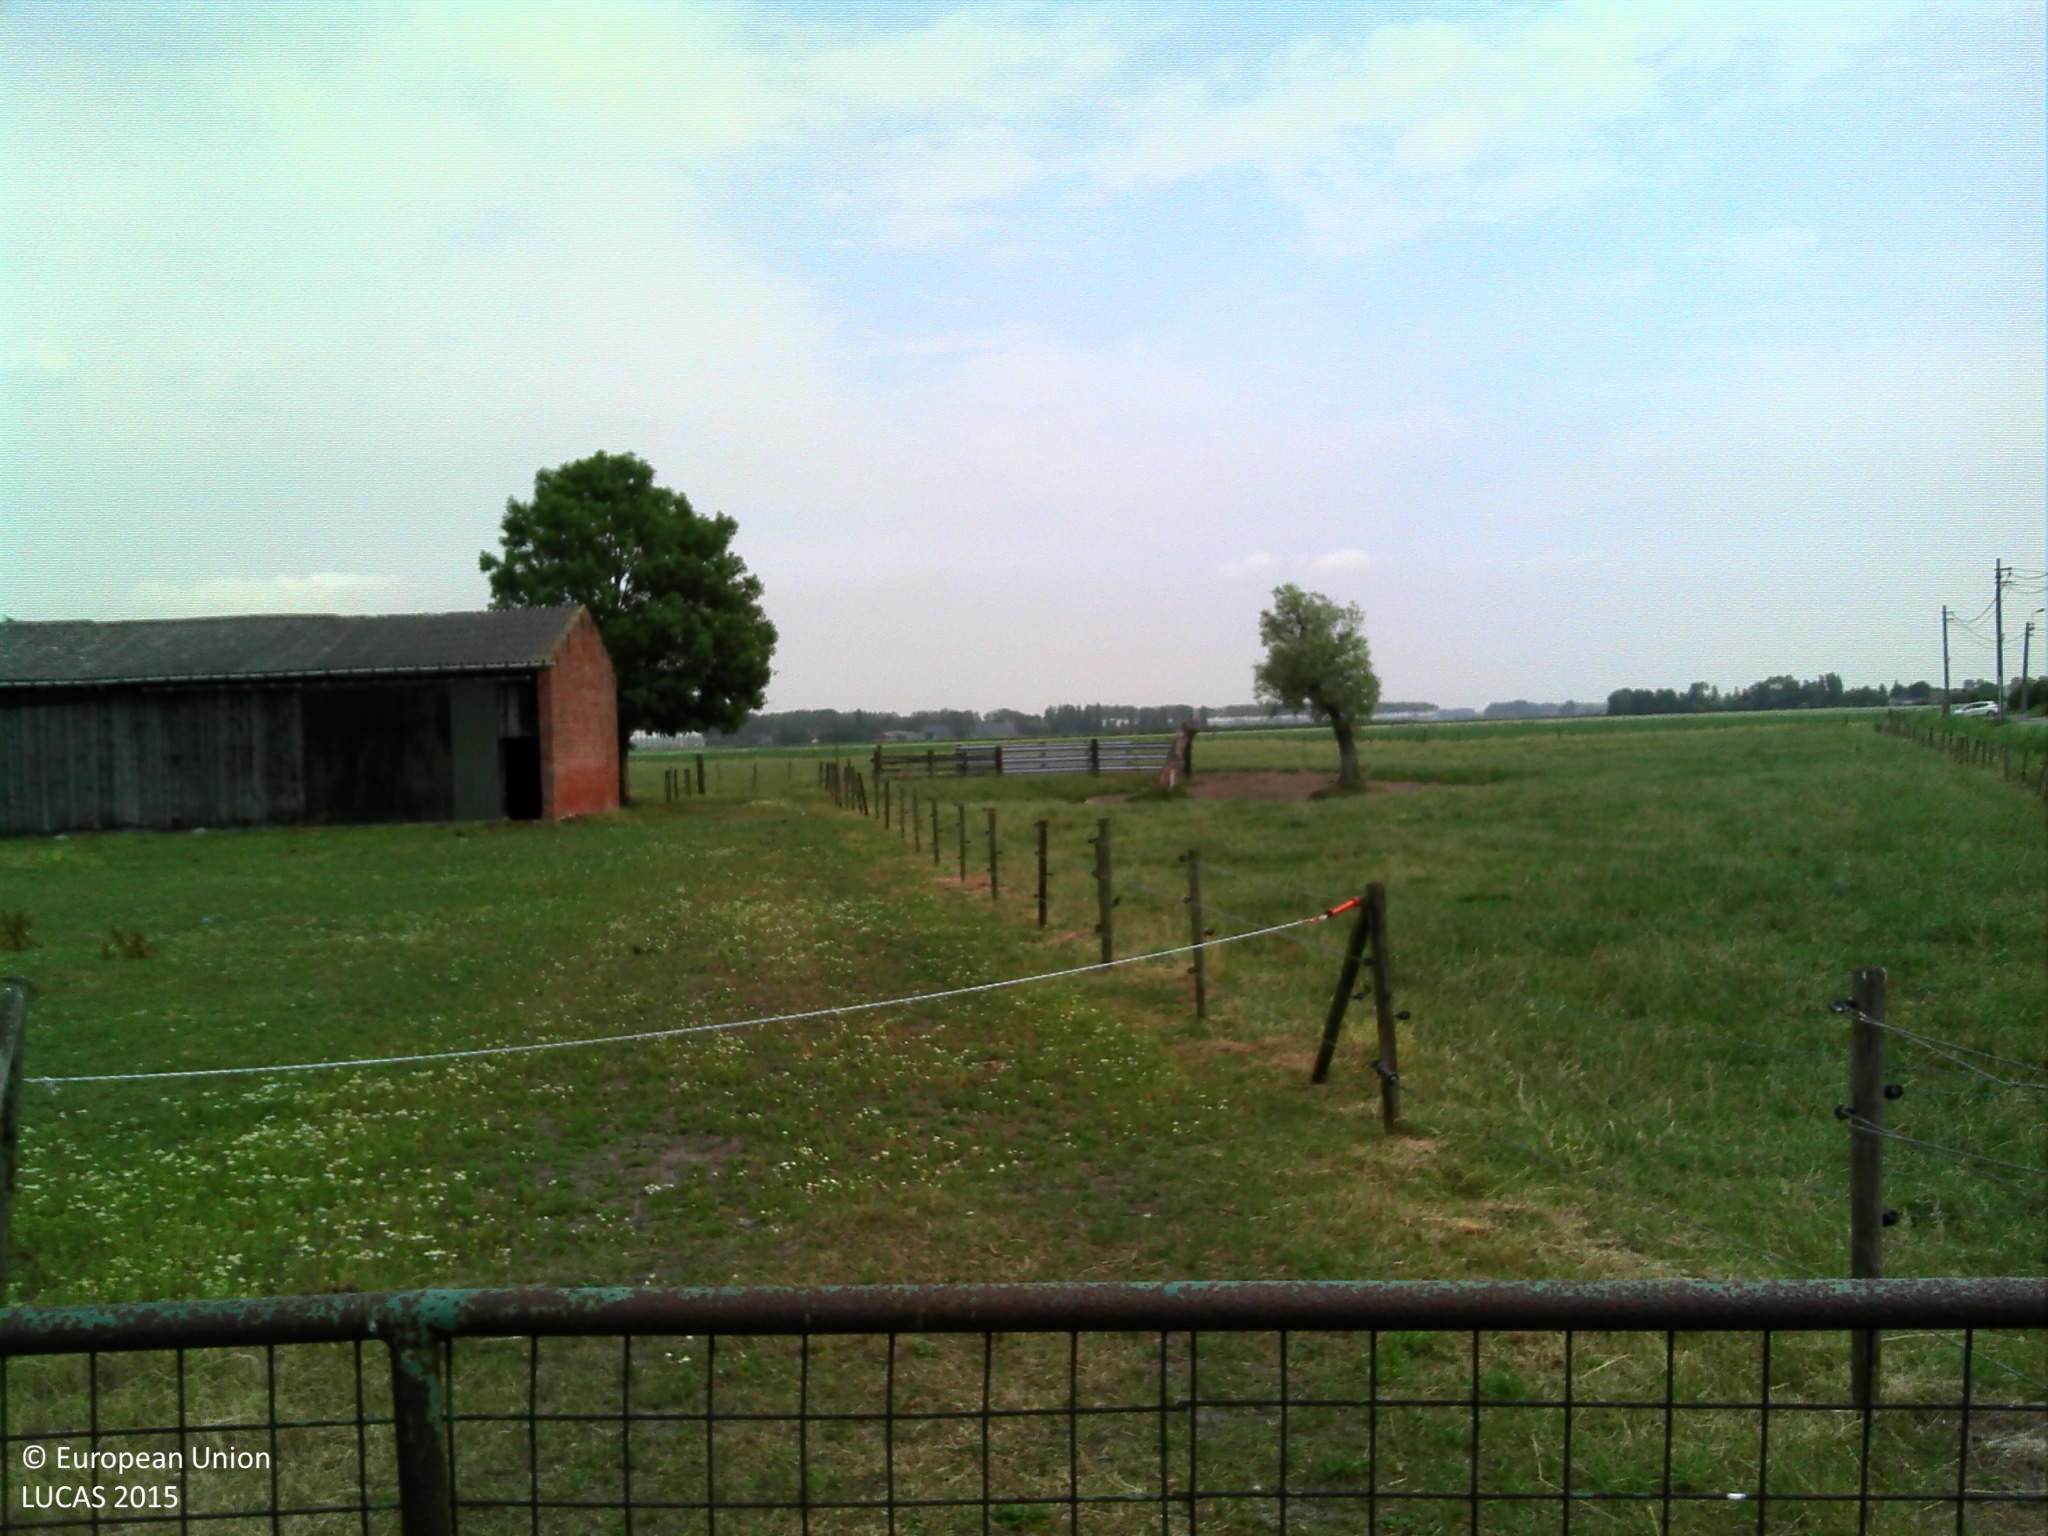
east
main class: Grassland
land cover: Grassland without tree/shrub cover
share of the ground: > 75 %
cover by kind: herbaceous plants 100 %
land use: Agriculture (excluding fallow land and kitchen gardens)
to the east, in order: Grassland without tree/shrub cover; Artificial constructions in urban areas; Grass margins; Inland fresh water bodies; Grassland without tree/shrub cover; Fences; Grassland without tree/shrub cover; Fences; Maize
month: July
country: BE
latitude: 51.2873
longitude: 3.6407
